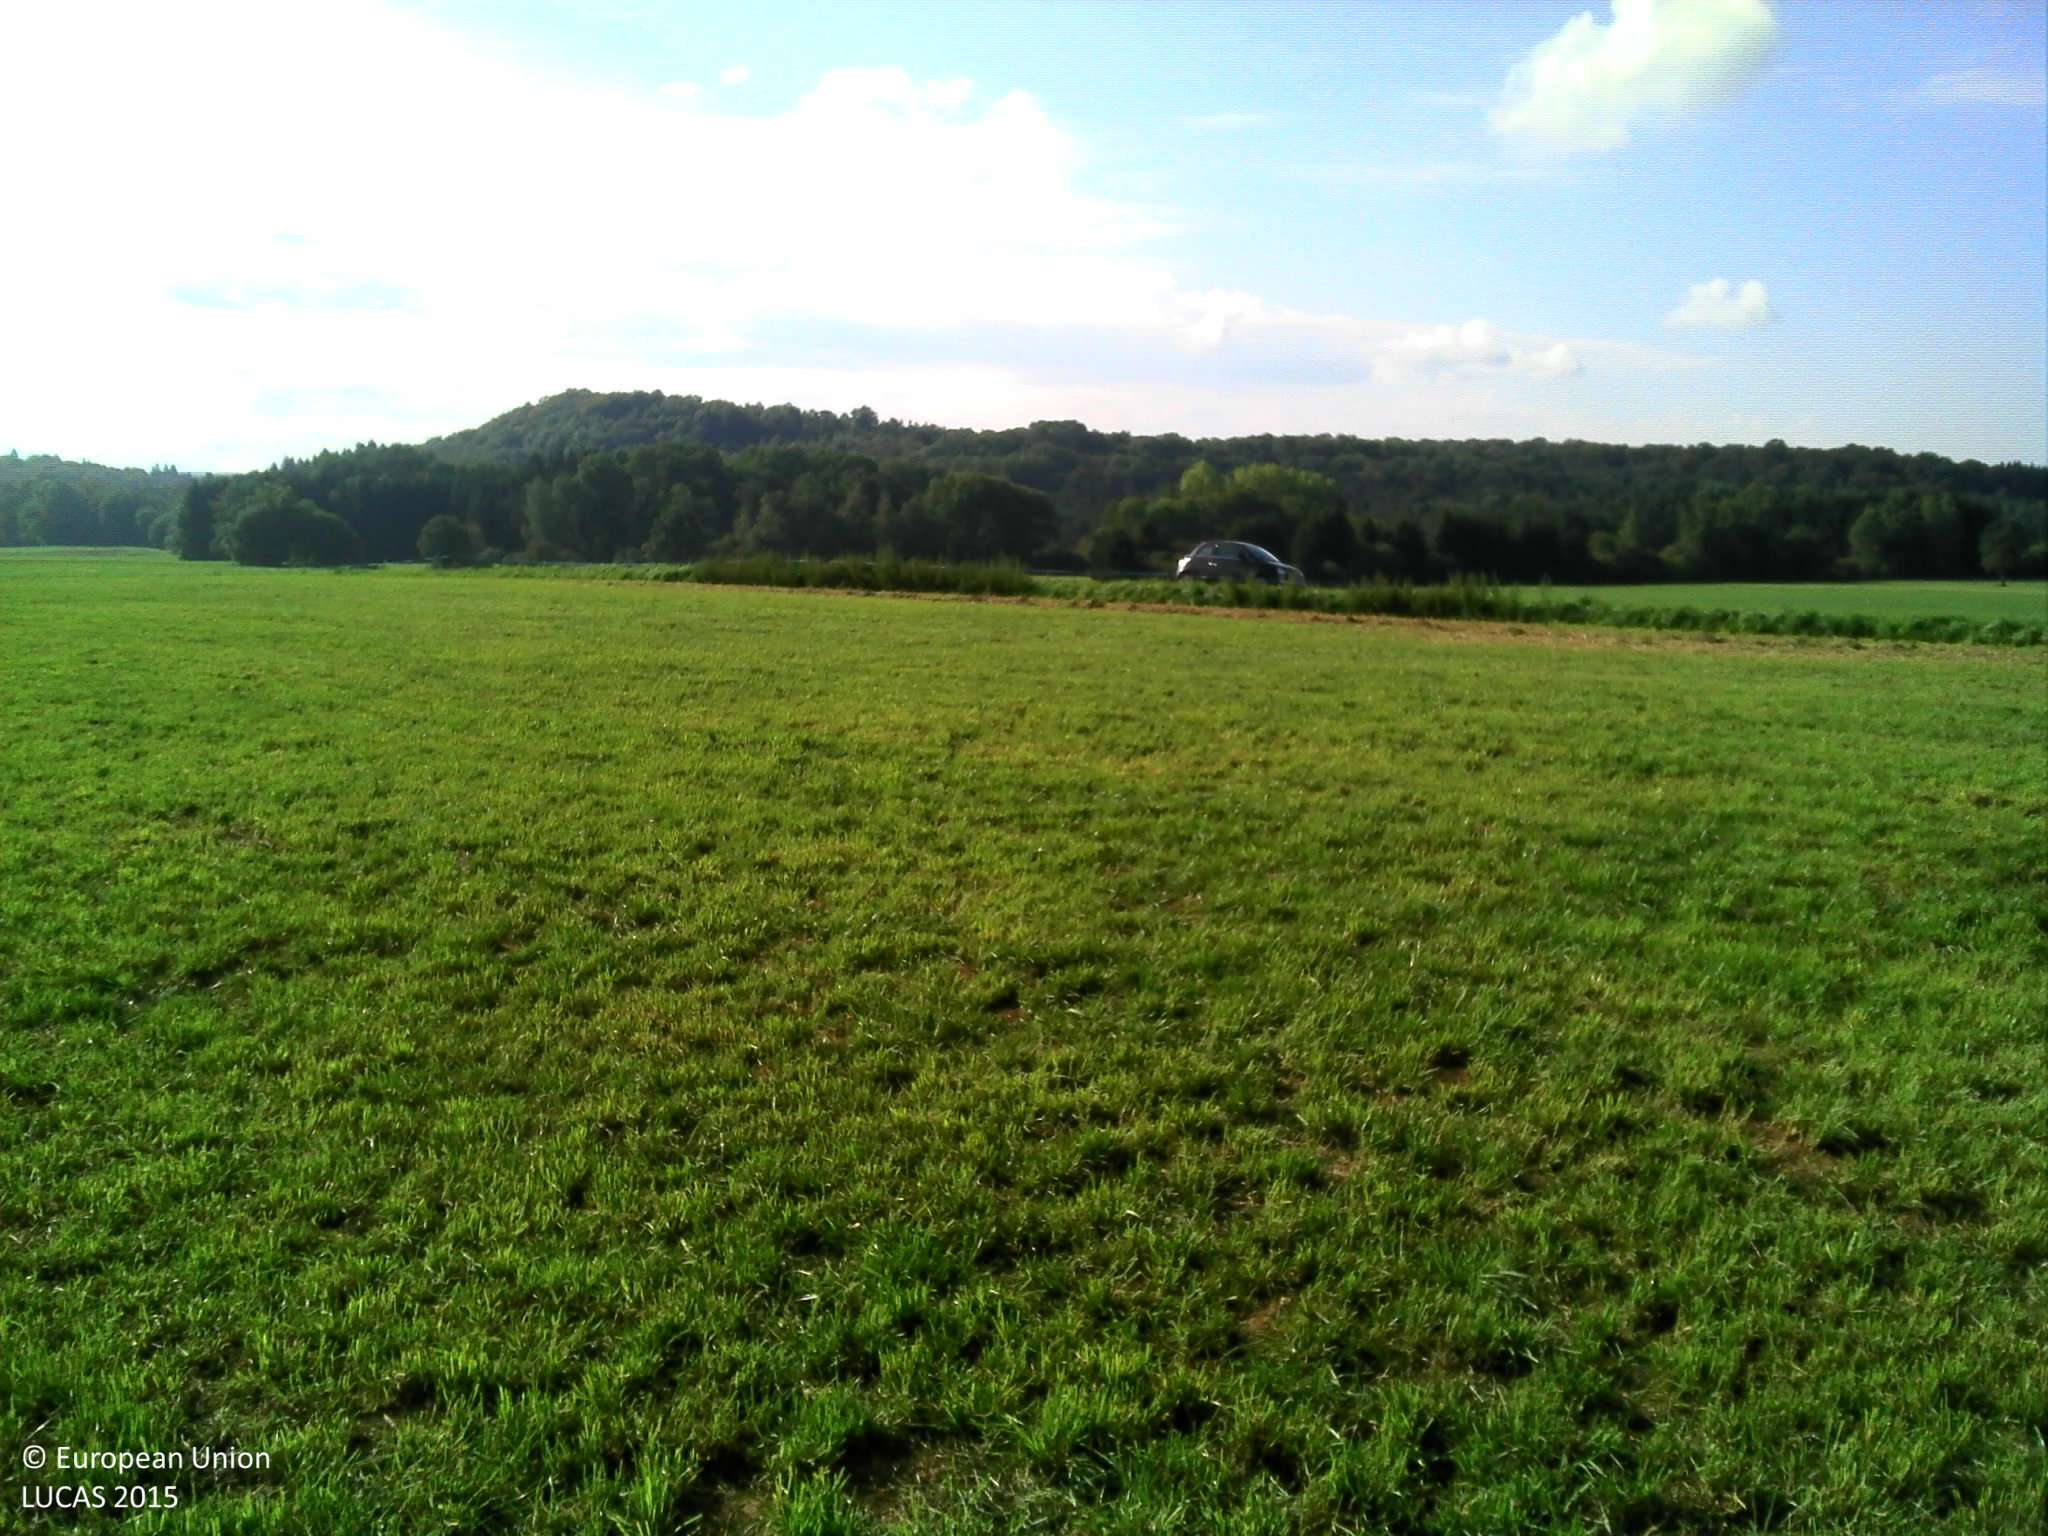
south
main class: Grassland
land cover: Grassland without tree/shrub cover
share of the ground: > 75 %
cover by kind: herbaceous plants 100 %
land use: Agriculture (excluding fallow land and kitchen gardens)
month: September
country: FR
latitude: 47.2261
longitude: 6.3436
